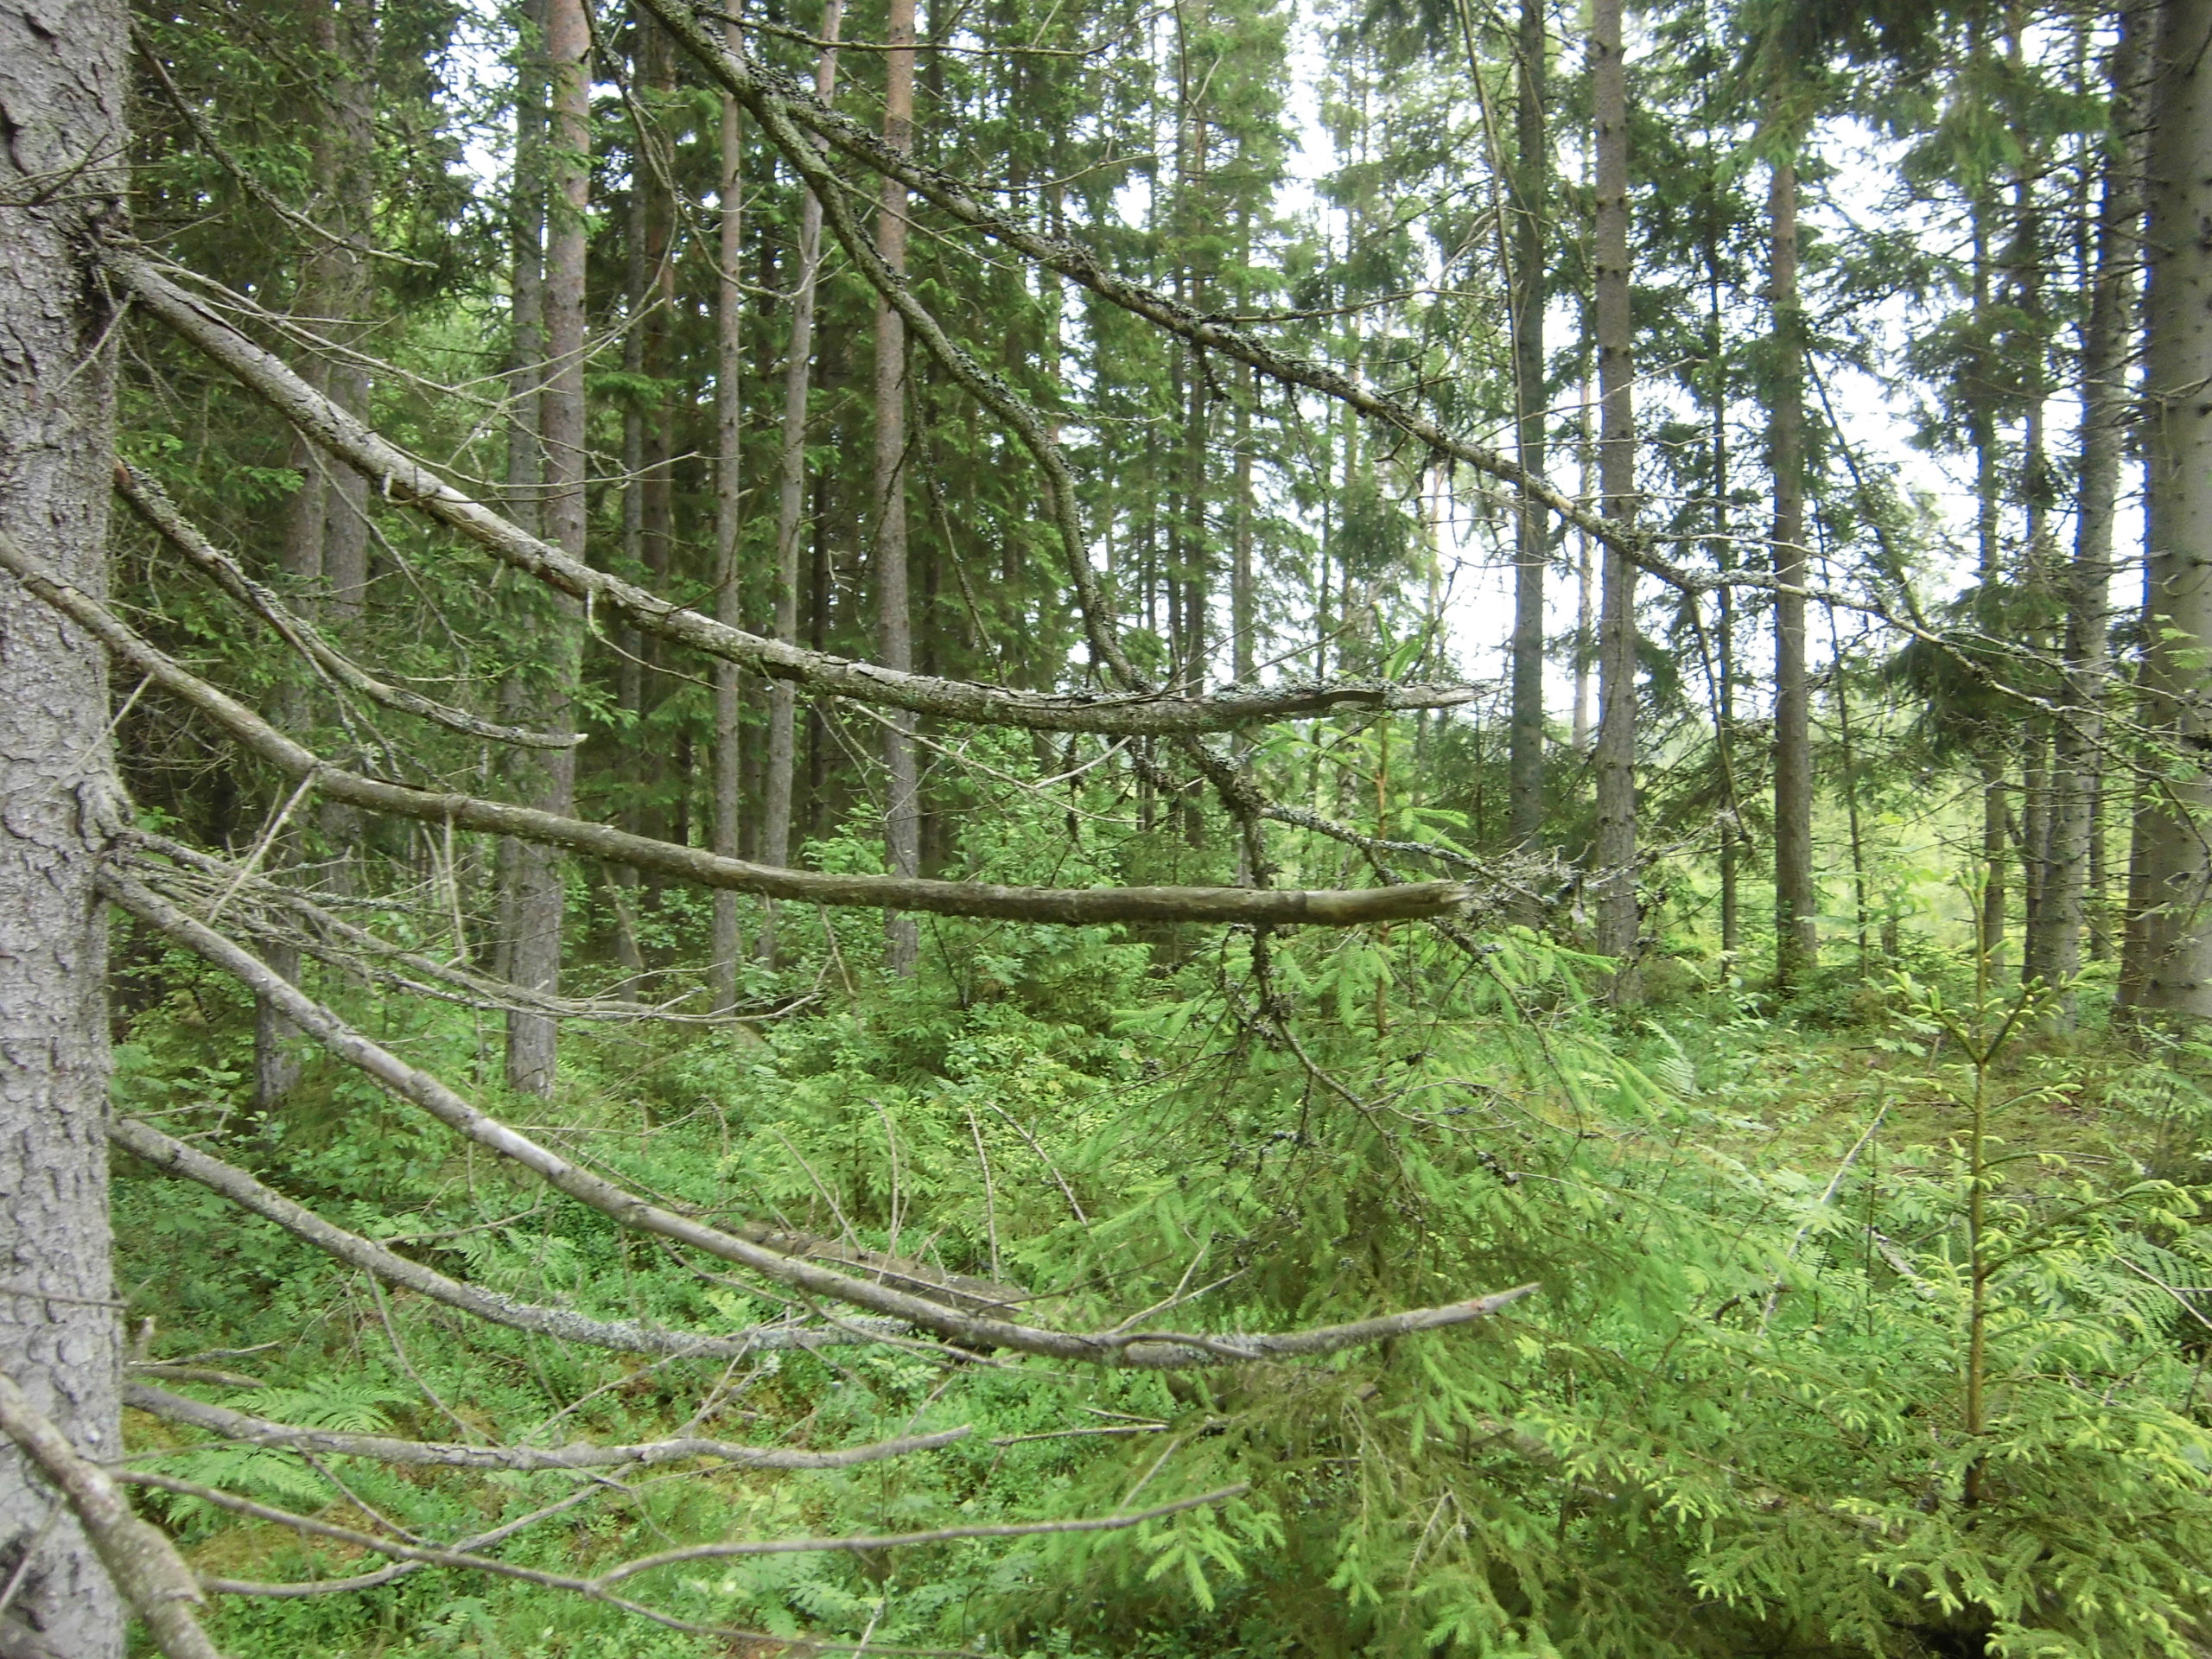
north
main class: Woodland
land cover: Spruce dominated coniferous woodland
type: boreal forest
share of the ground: 50 - 75 %
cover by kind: coniferous forest trees 55 %, shrubs 15 %, broadleaved forest trees 10 %, herbaceous plants 10 %, lichens and mosses 10 %
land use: Forestry
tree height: > 5 m
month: June
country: SE
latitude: 57.0159
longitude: 14.8225
